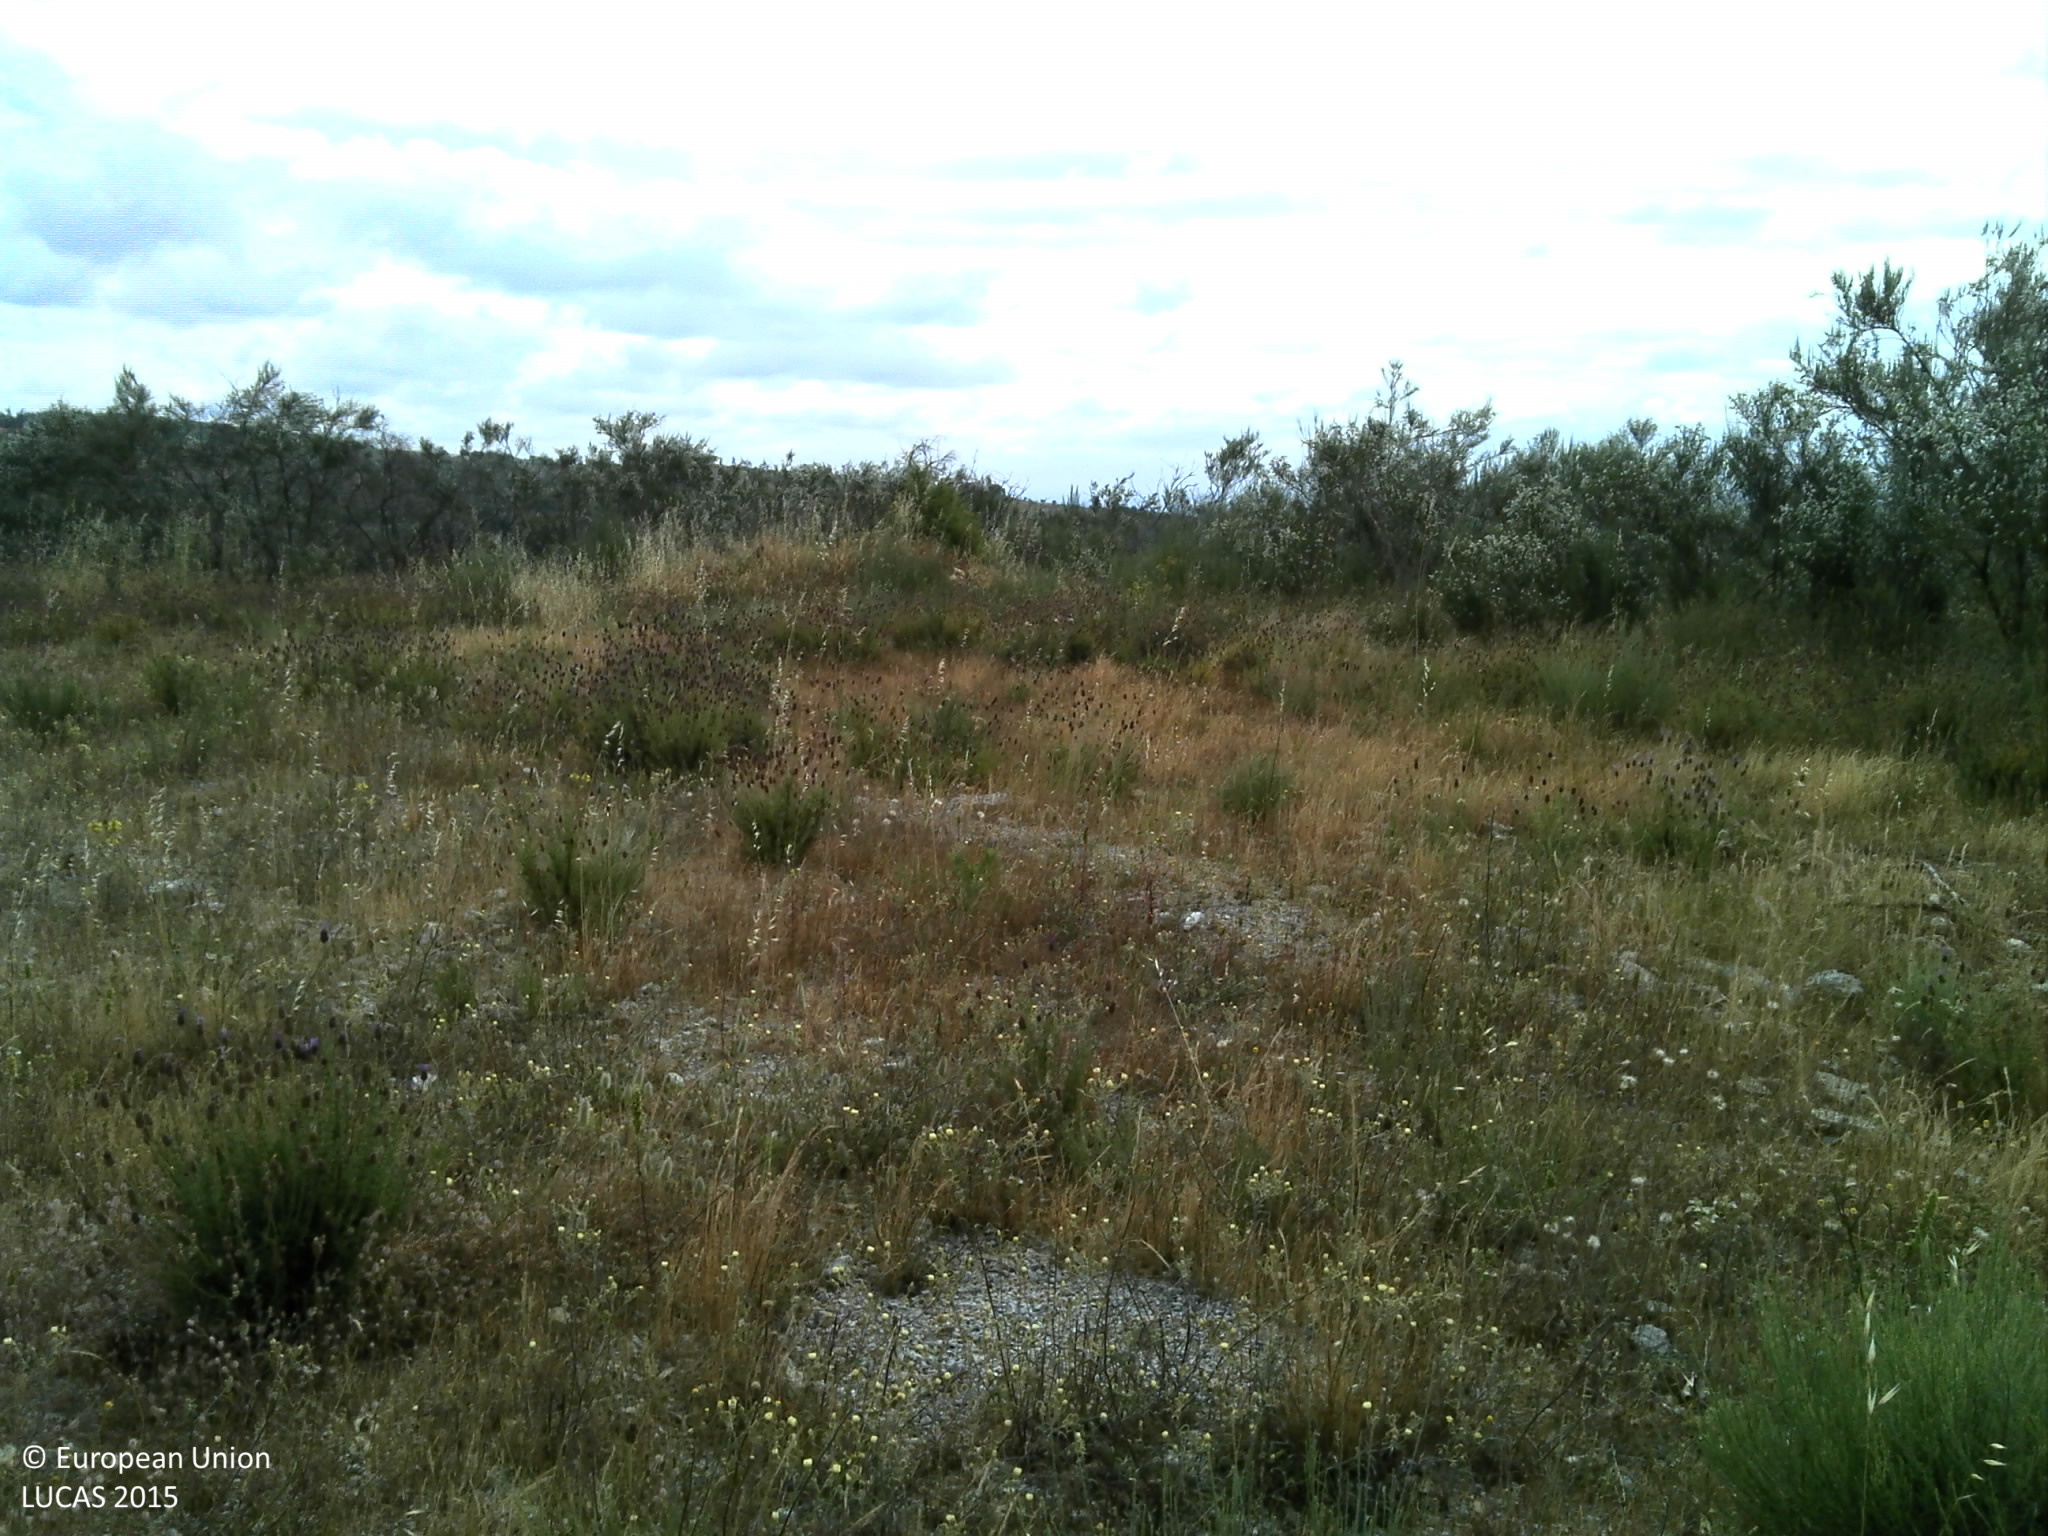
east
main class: Grassland
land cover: Grassland without tree/shrub cover
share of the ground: 10 - 25 %
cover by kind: consolidated bare surface 60 %, unconsolidated bare surface 20 %, herbaceous plants 15 %, shrubs 5 %
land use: Semi-natural and natural areas not in use
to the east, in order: Grassland without tree/shrub cover; Shrubland without tree cover; Shrubland with sparse tree cover; Tracks; Broadleaved woodland; Rivers and streams; Shruby margins; Grassland without tree/shrub cover; Nuts trees
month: June
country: PT
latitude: 41.3909
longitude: -6.9873
